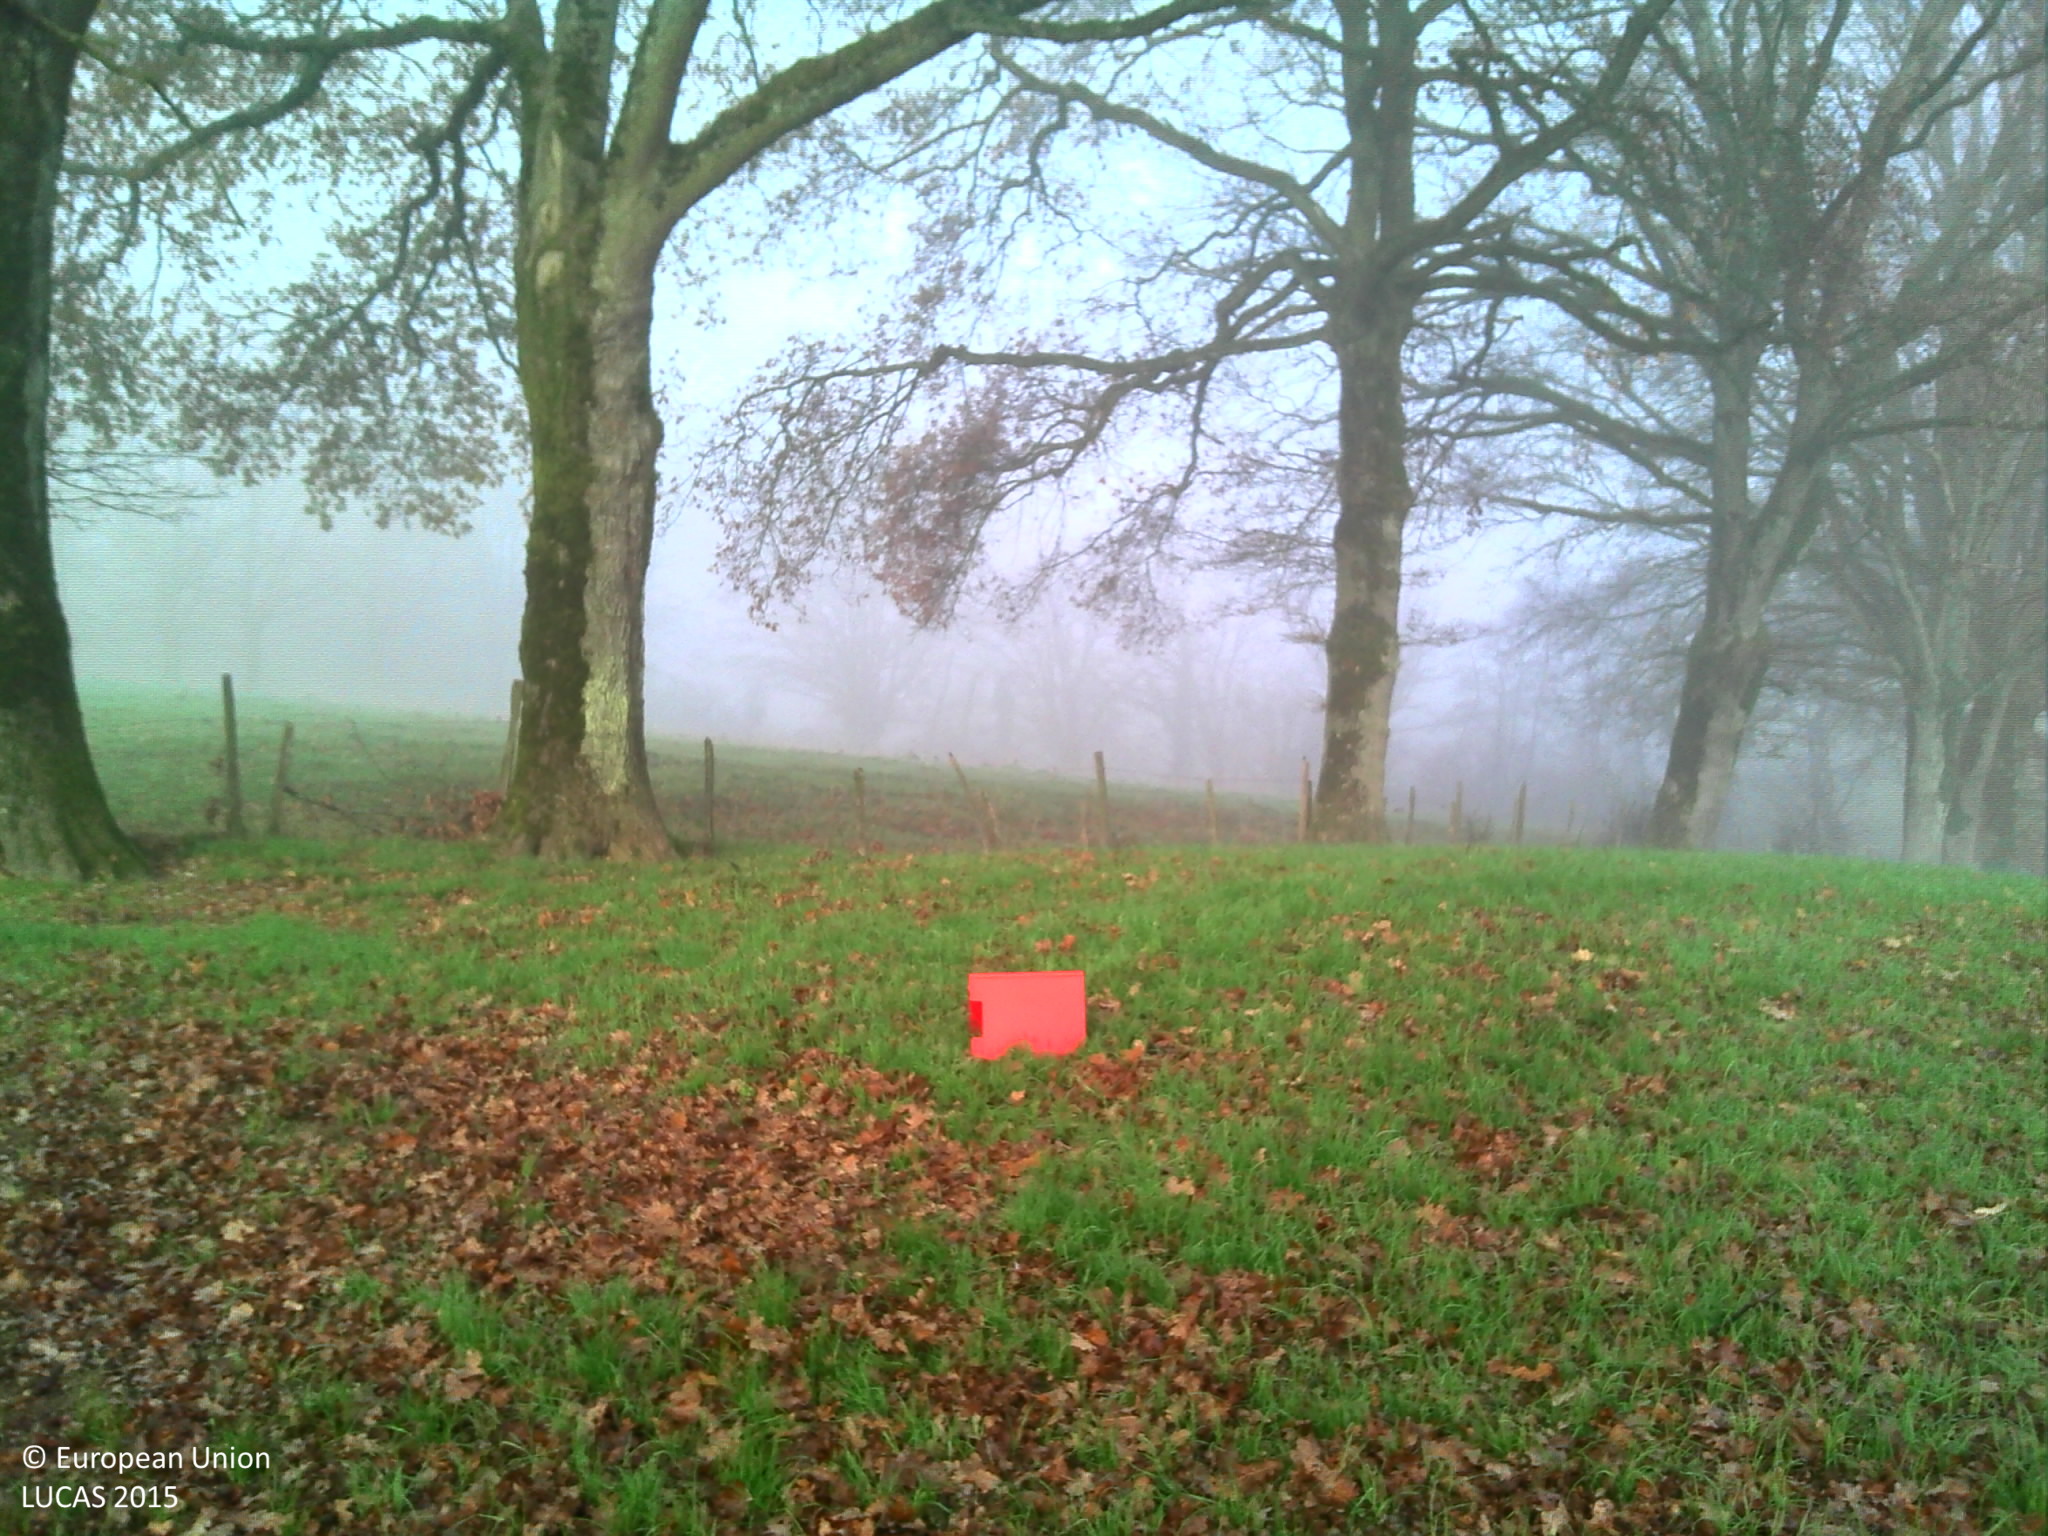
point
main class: Cropland
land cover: Temporary grasslands
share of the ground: > 75 %
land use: Agriculture (excluding fallow land and kitchen gardens)
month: December
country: FR
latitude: 46.3544
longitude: 5.2593
